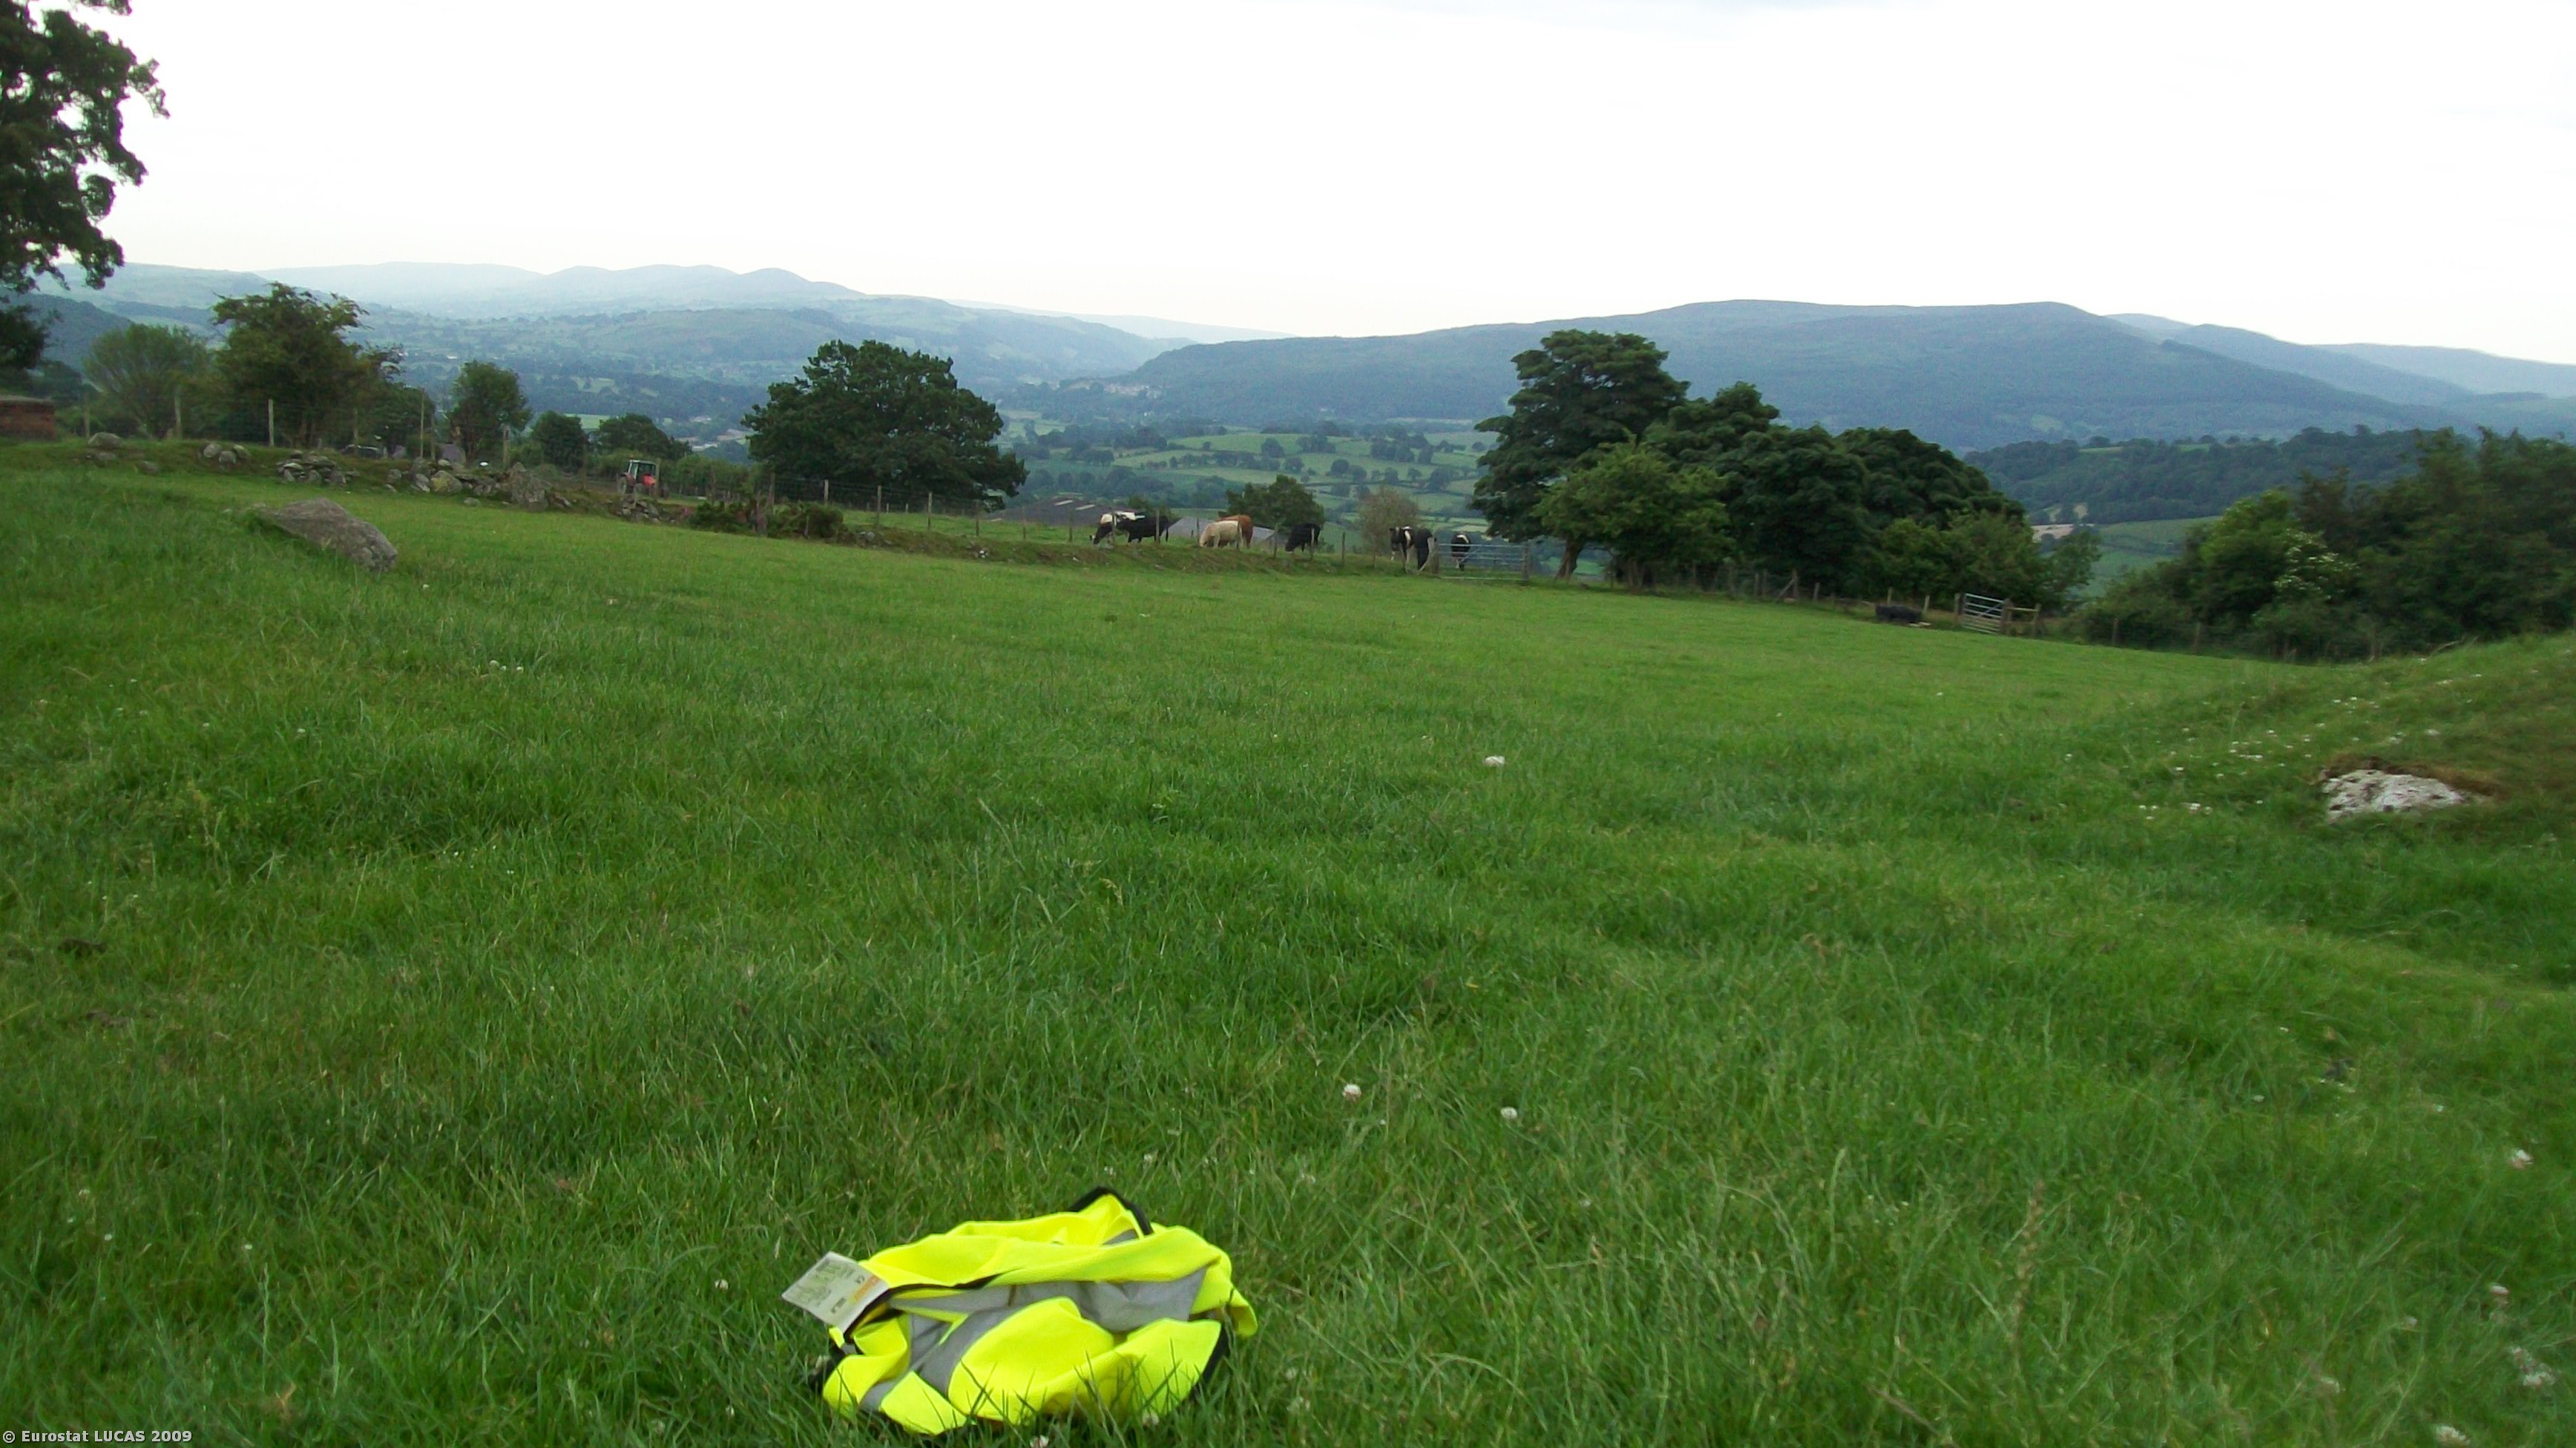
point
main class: Grassland
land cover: Grassland without tree/shrub cover
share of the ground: > 75 %
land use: Agriculture (excluding fallow land and kitchen gardens)
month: July
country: GB
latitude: 52.9730
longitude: -3.4708
